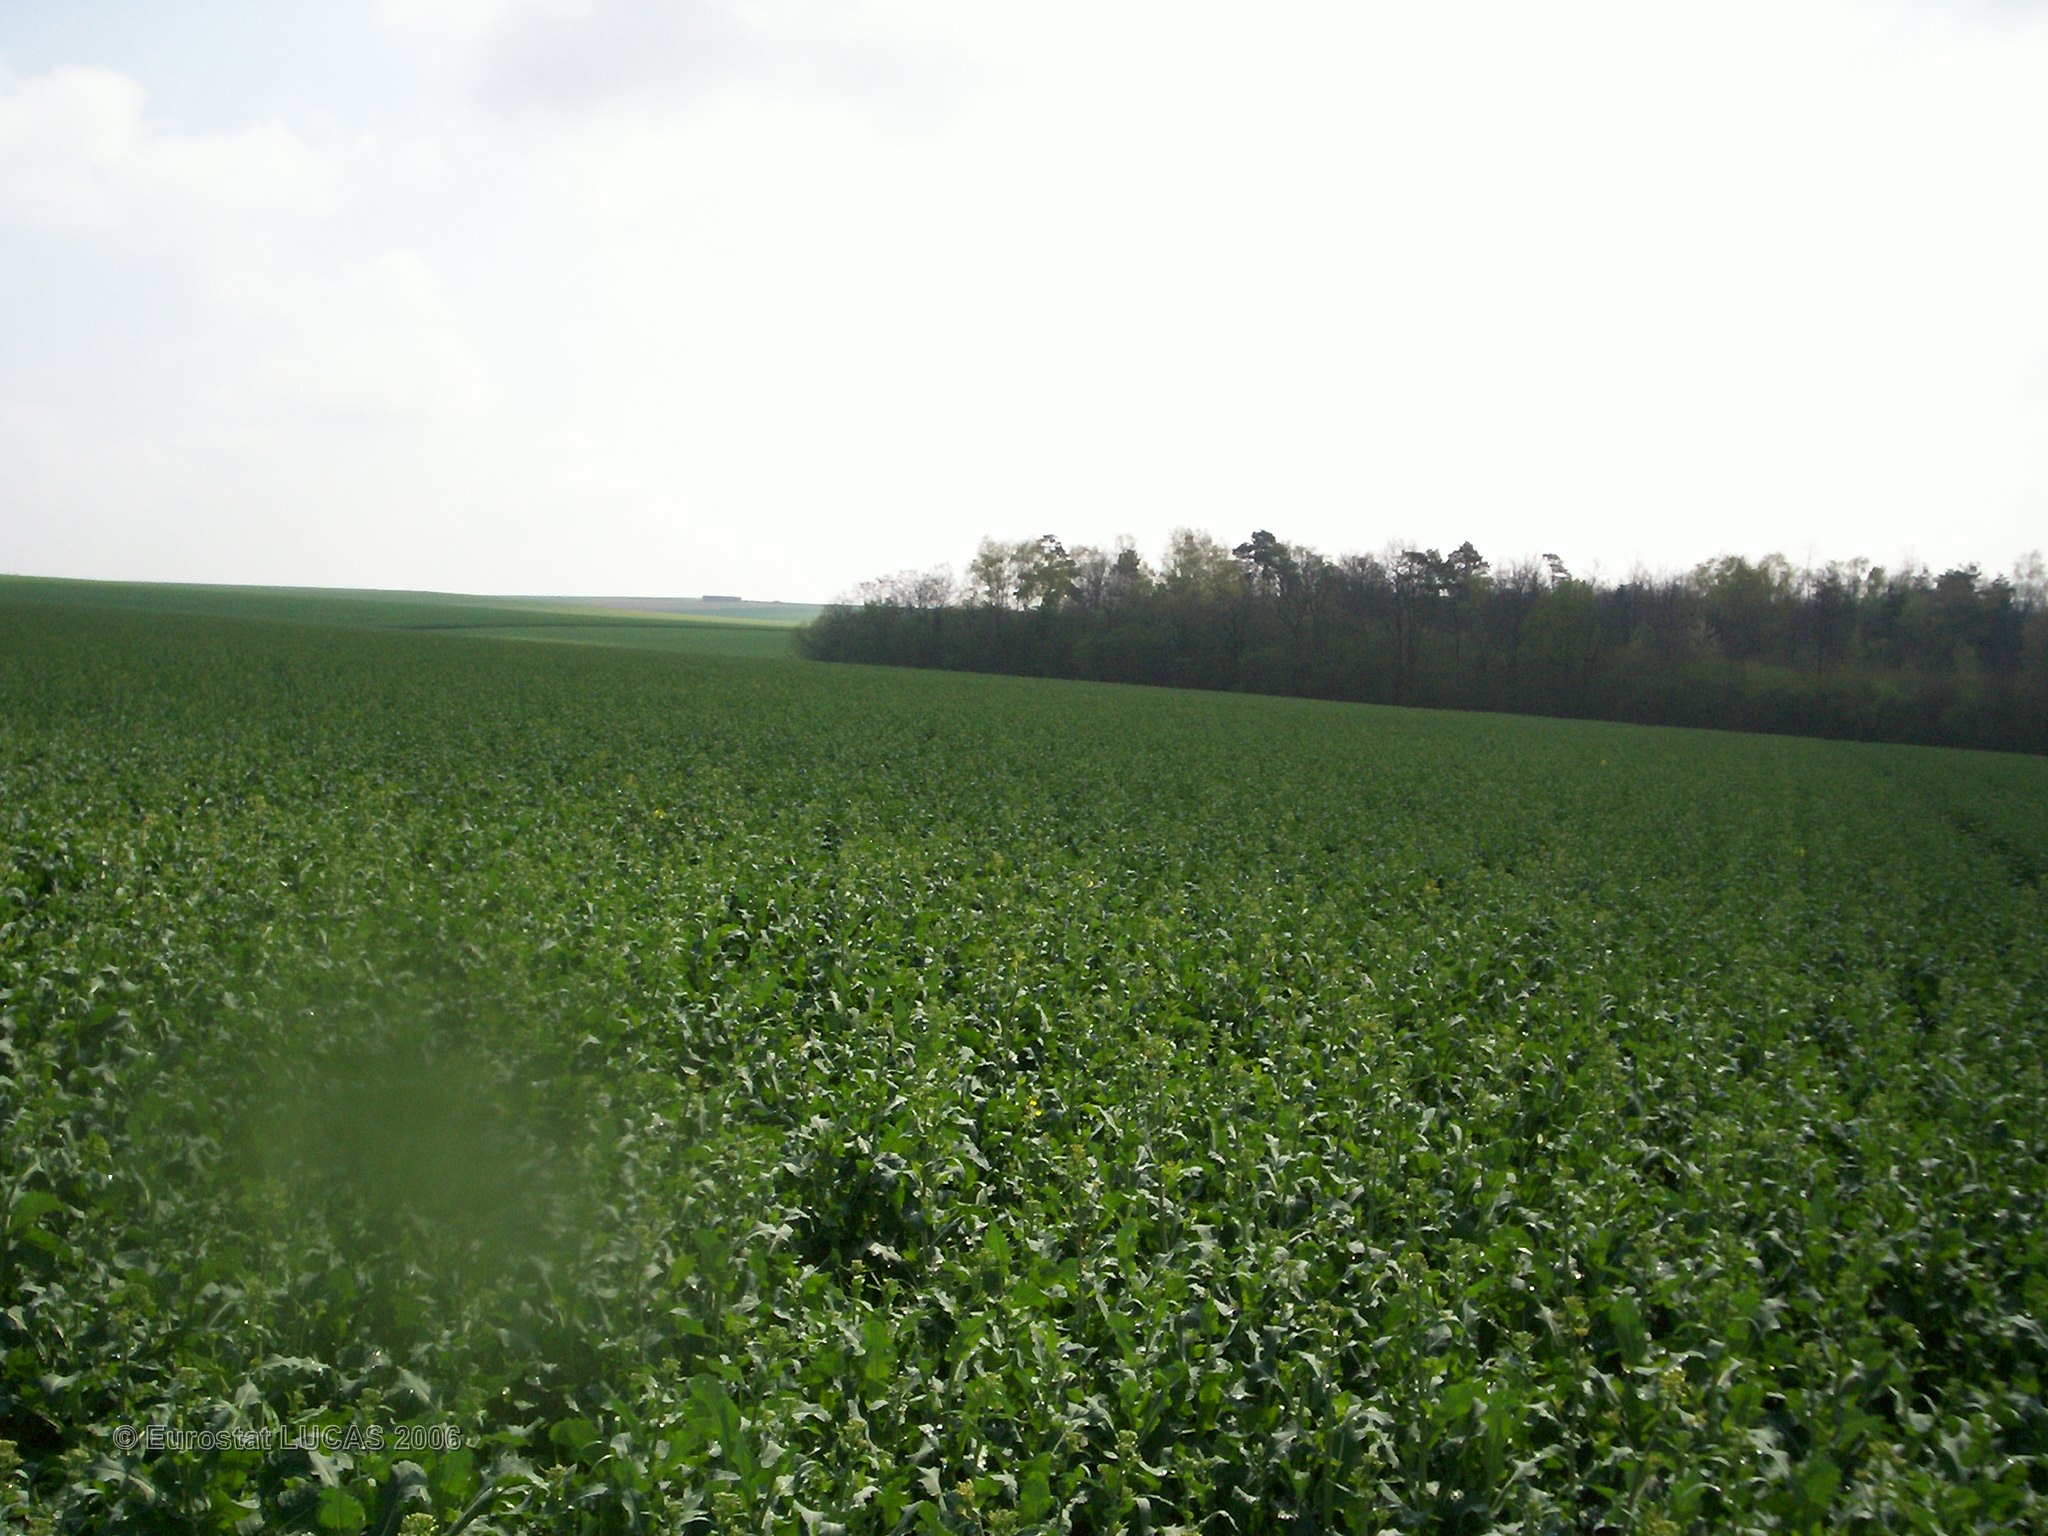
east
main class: Cropland
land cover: Rape and turnip rape
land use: Agriculture (excluding fallow land and kitchen gardens)
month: April
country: FR
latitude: 47.7449
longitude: 3.8483
